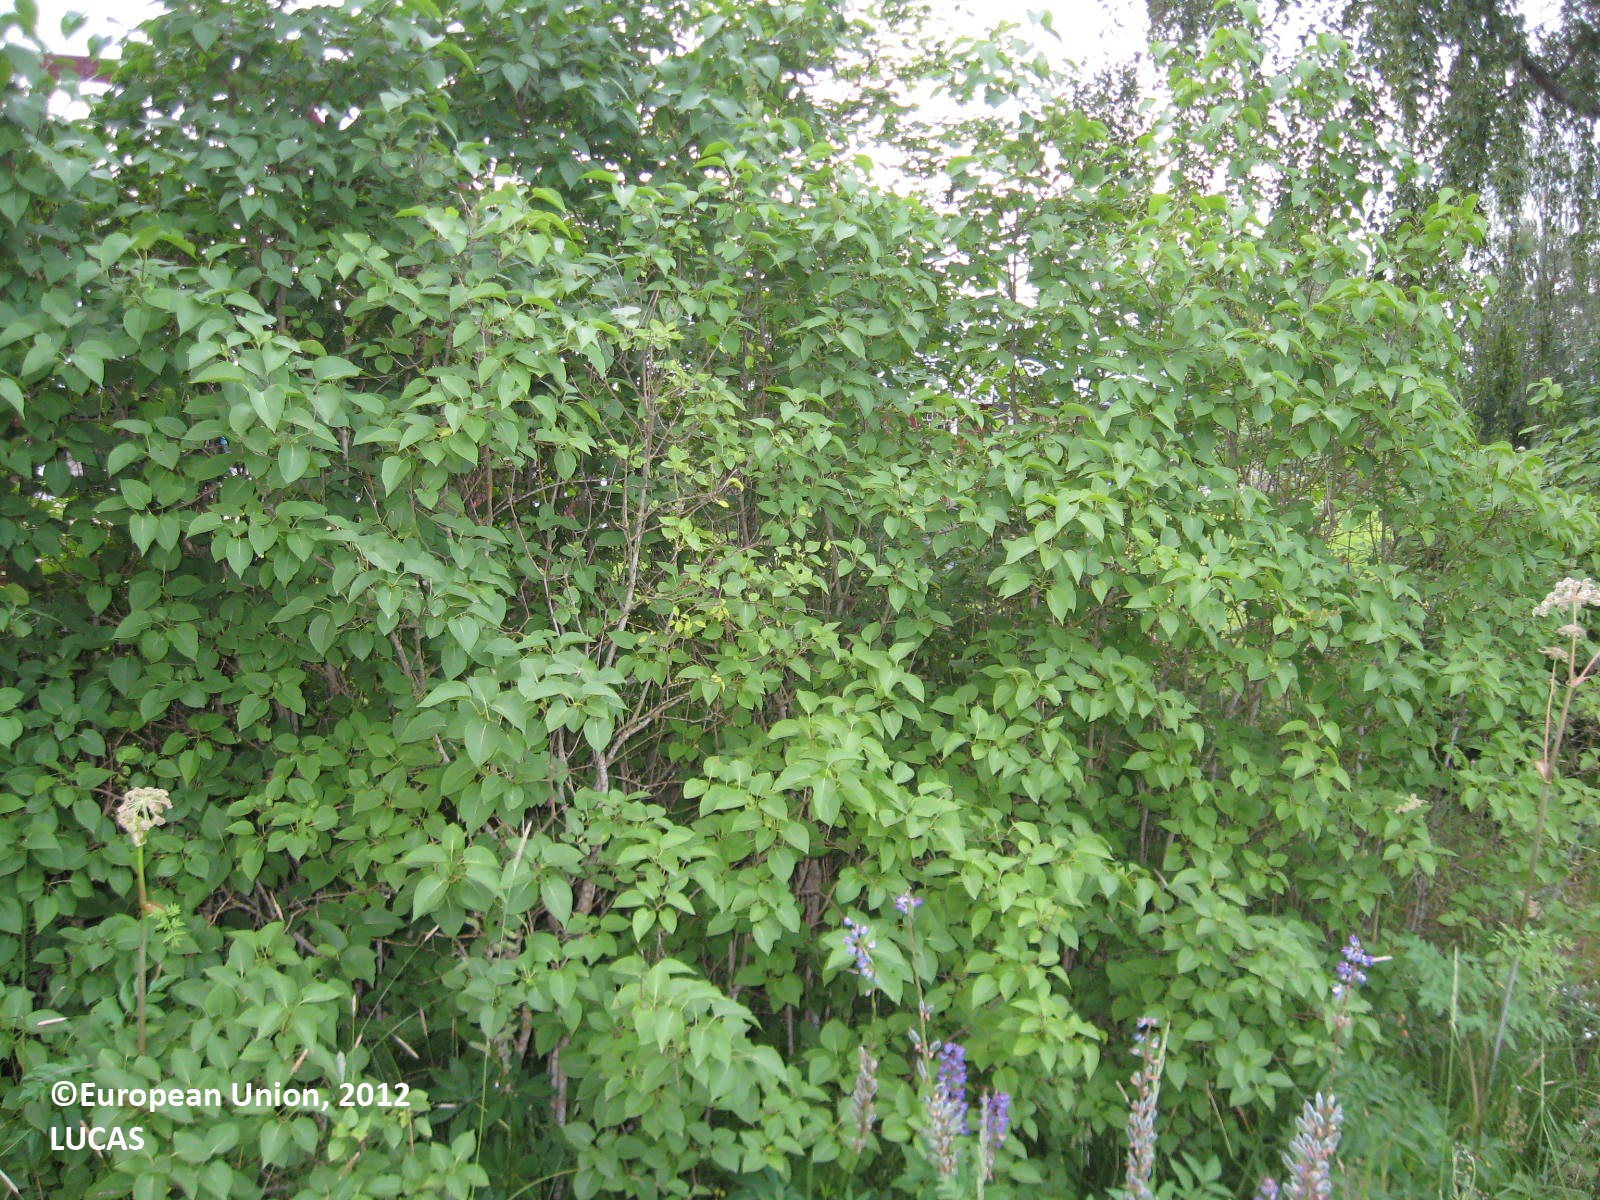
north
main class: Grassland
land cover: Grassland without tree/shrub cover
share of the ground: > 75 %
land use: Residential
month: July
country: FI
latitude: 62.5391
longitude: 21.4526
